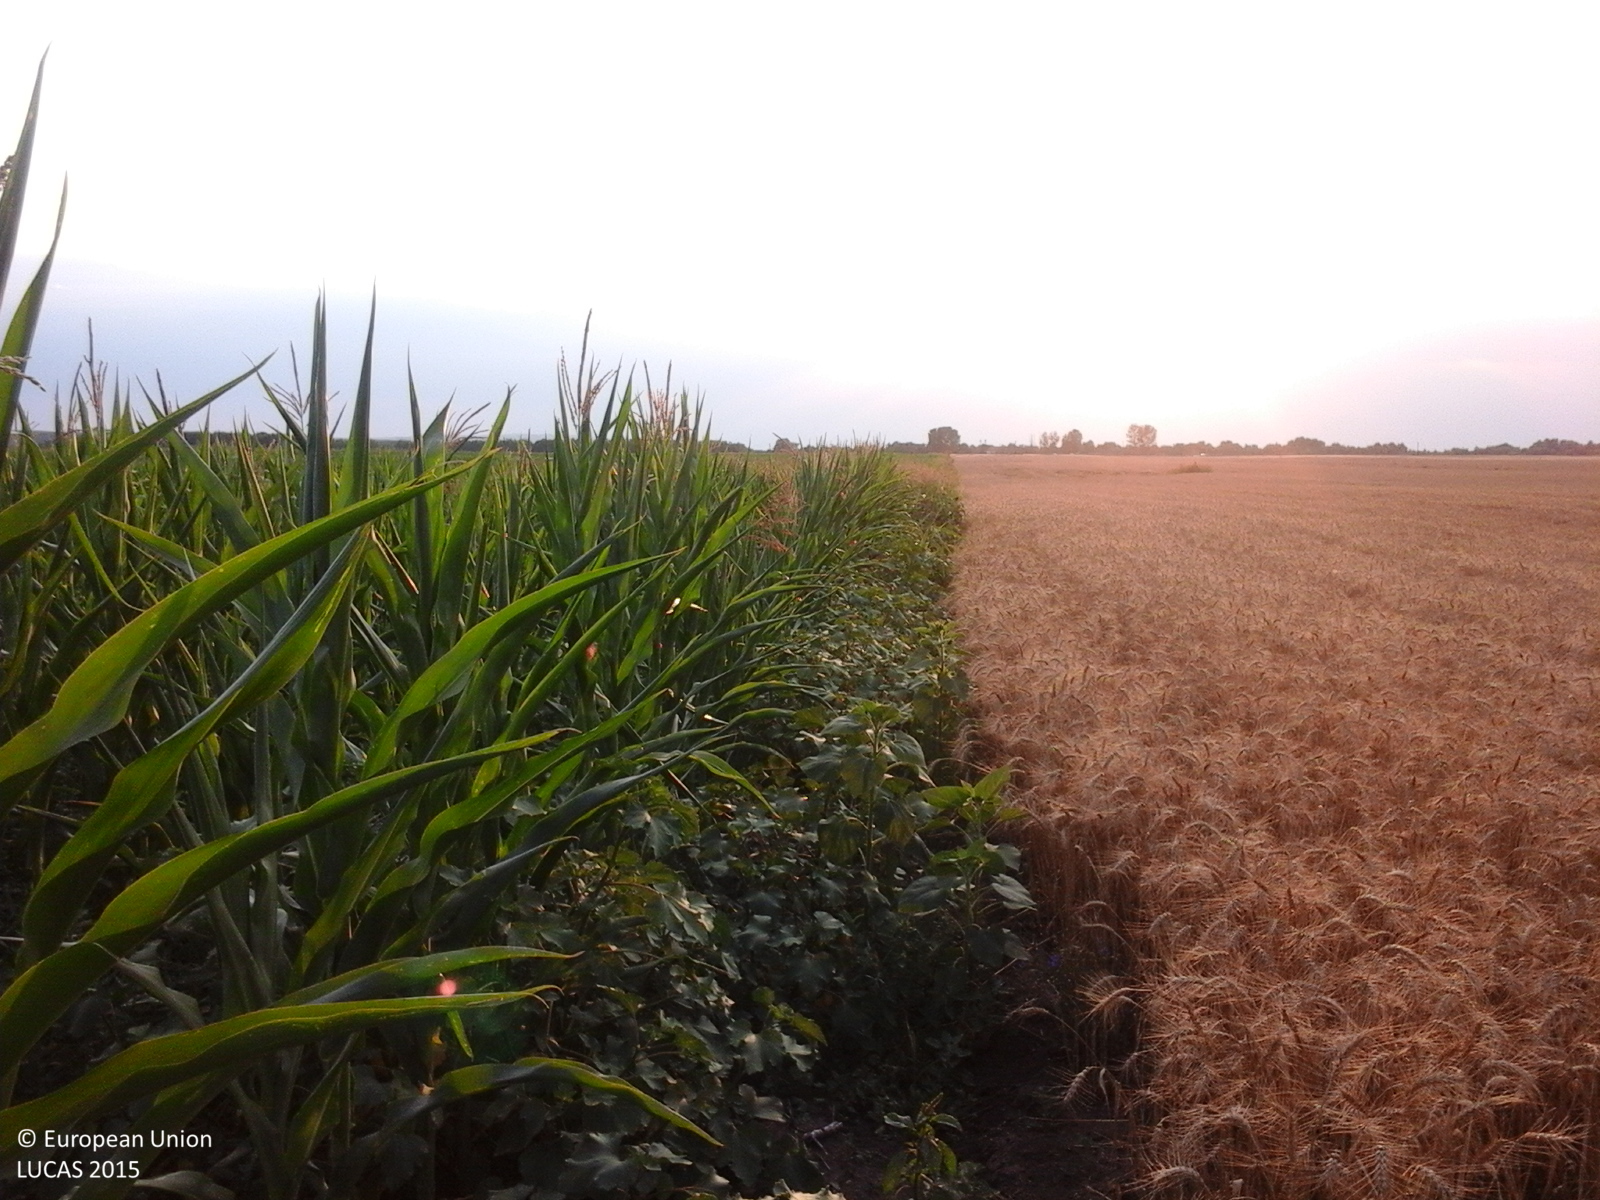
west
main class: Cropland
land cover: Common wheat
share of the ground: > 75 %
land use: Agriculture (excluding fallow land and kitchen gardens)
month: July
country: RO
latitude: 43.7198
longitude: 24.1710
